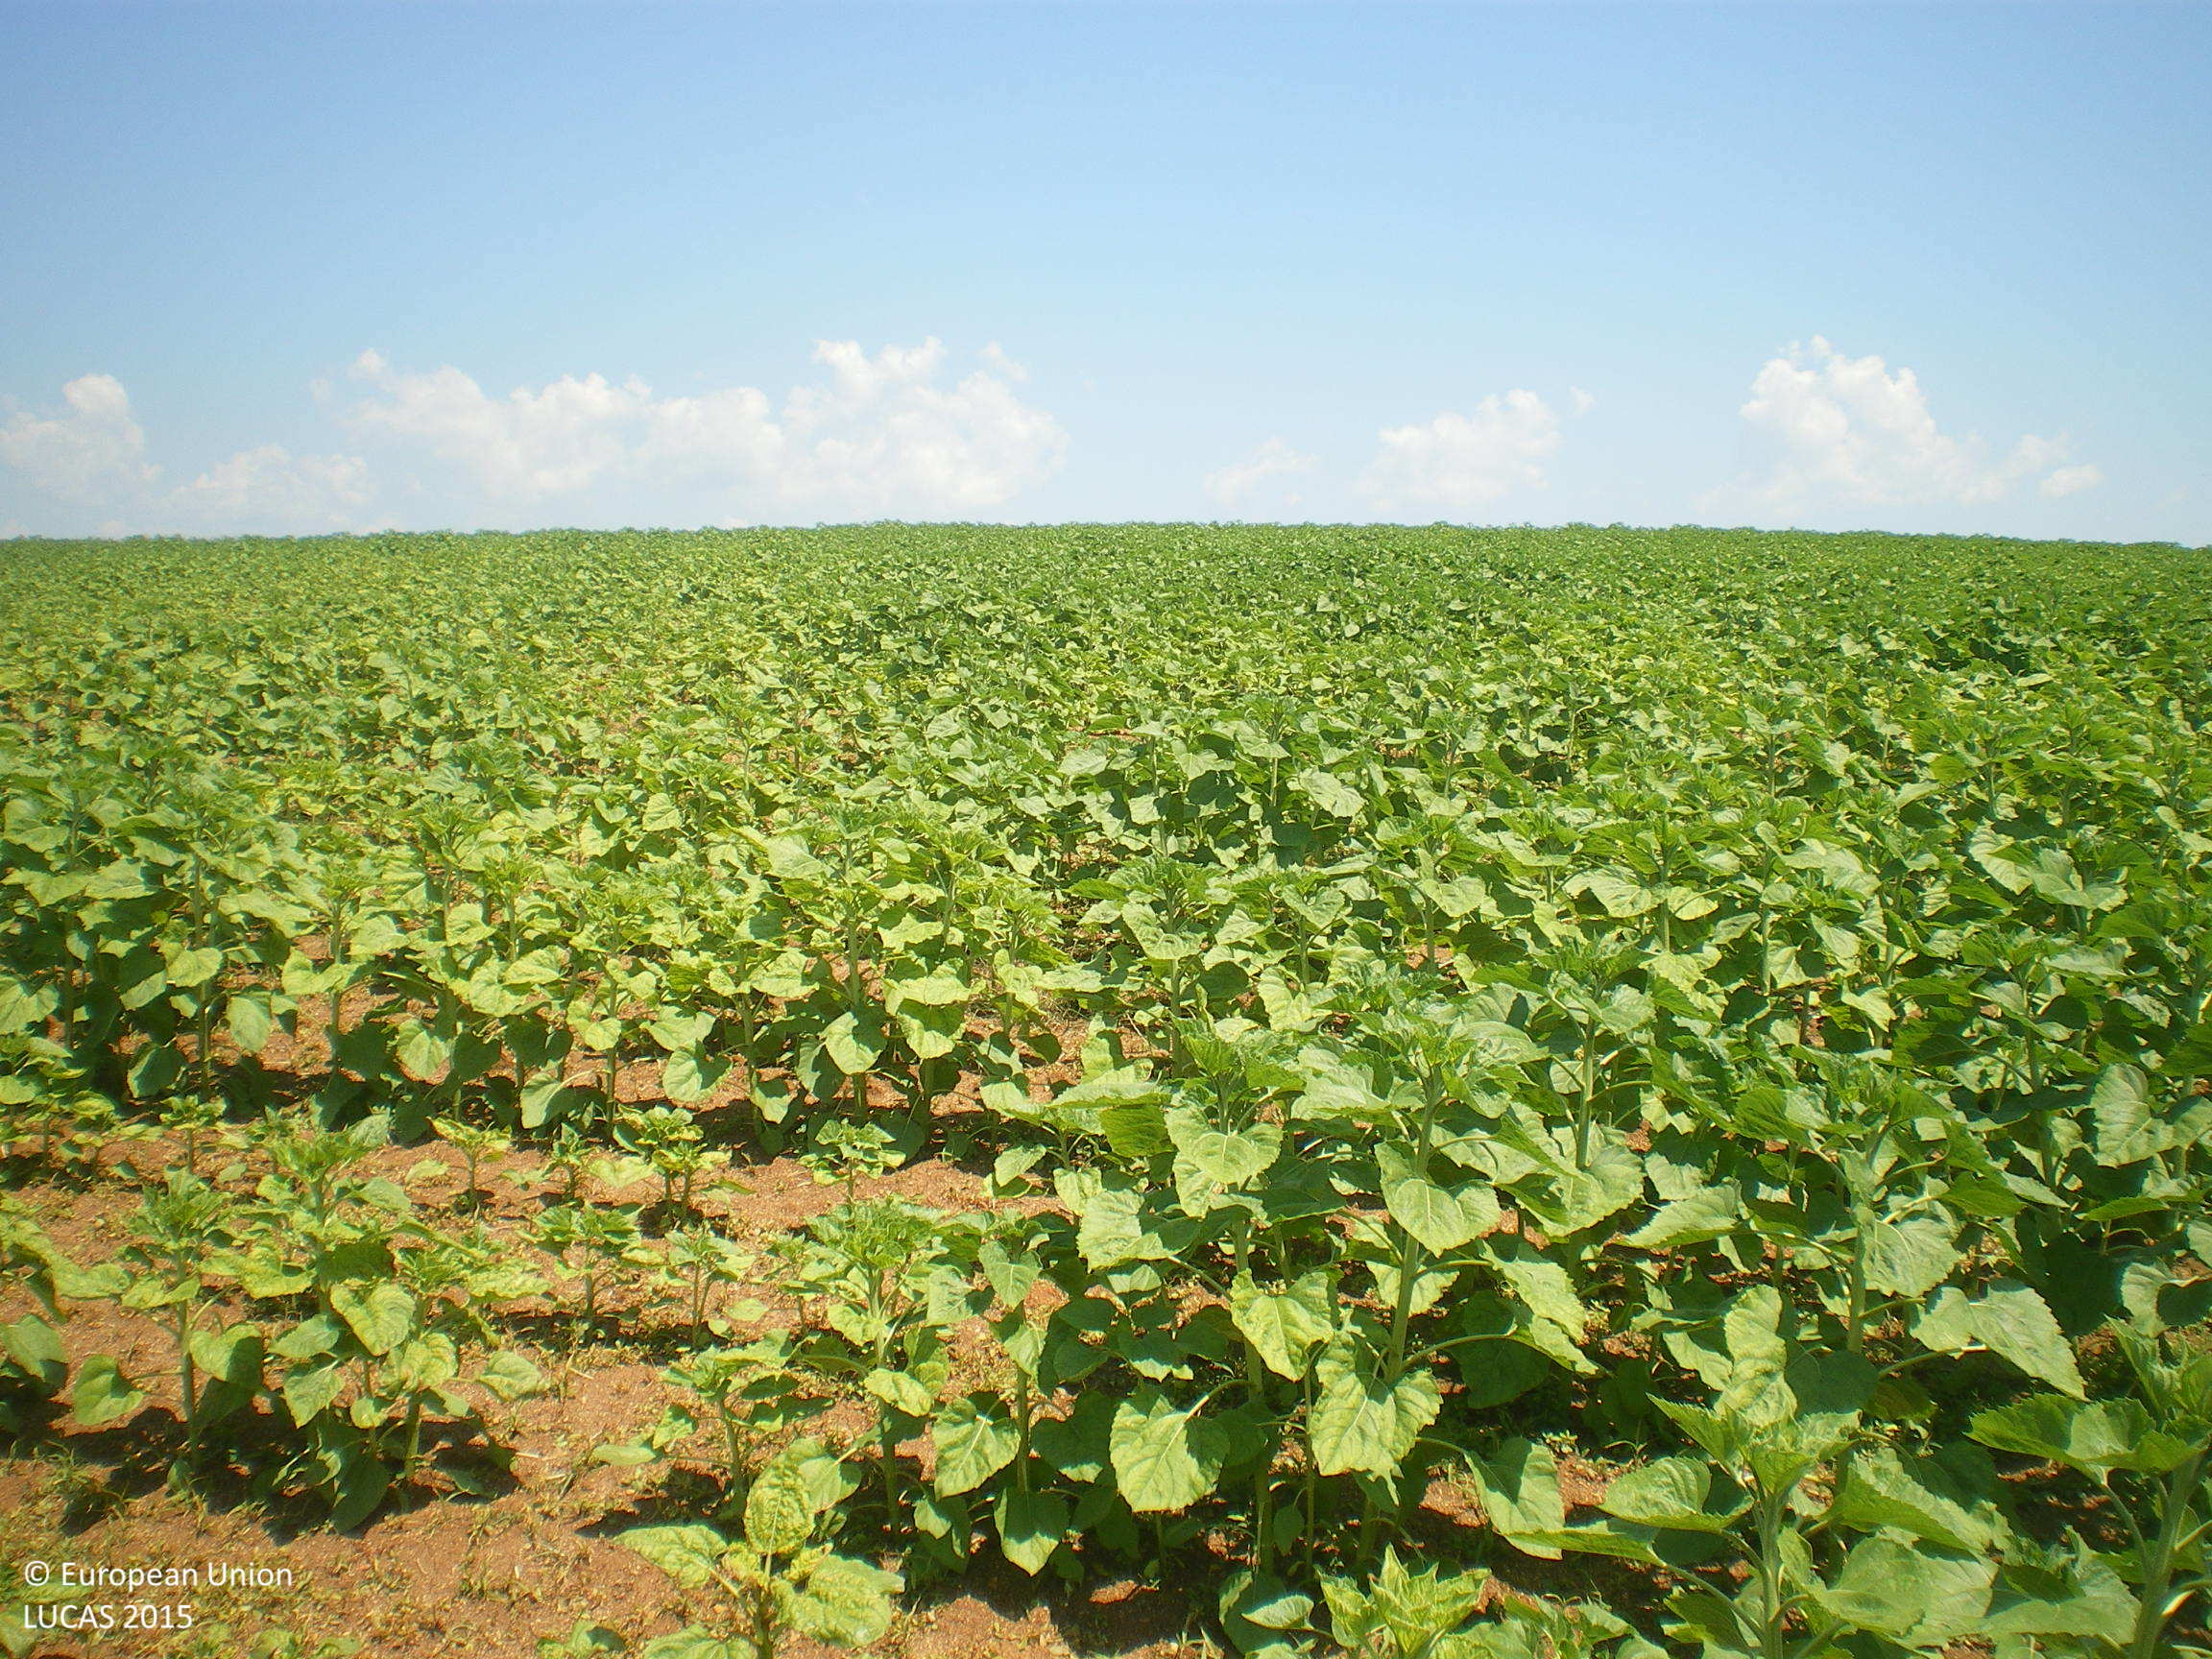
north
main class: Cropland
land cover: Sunflower
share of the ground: 50 - 75 %
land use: Agriculture (excluding fallow land and kitchen gardens)
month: June
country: BG
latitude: 42.2974
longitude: 25.1374
